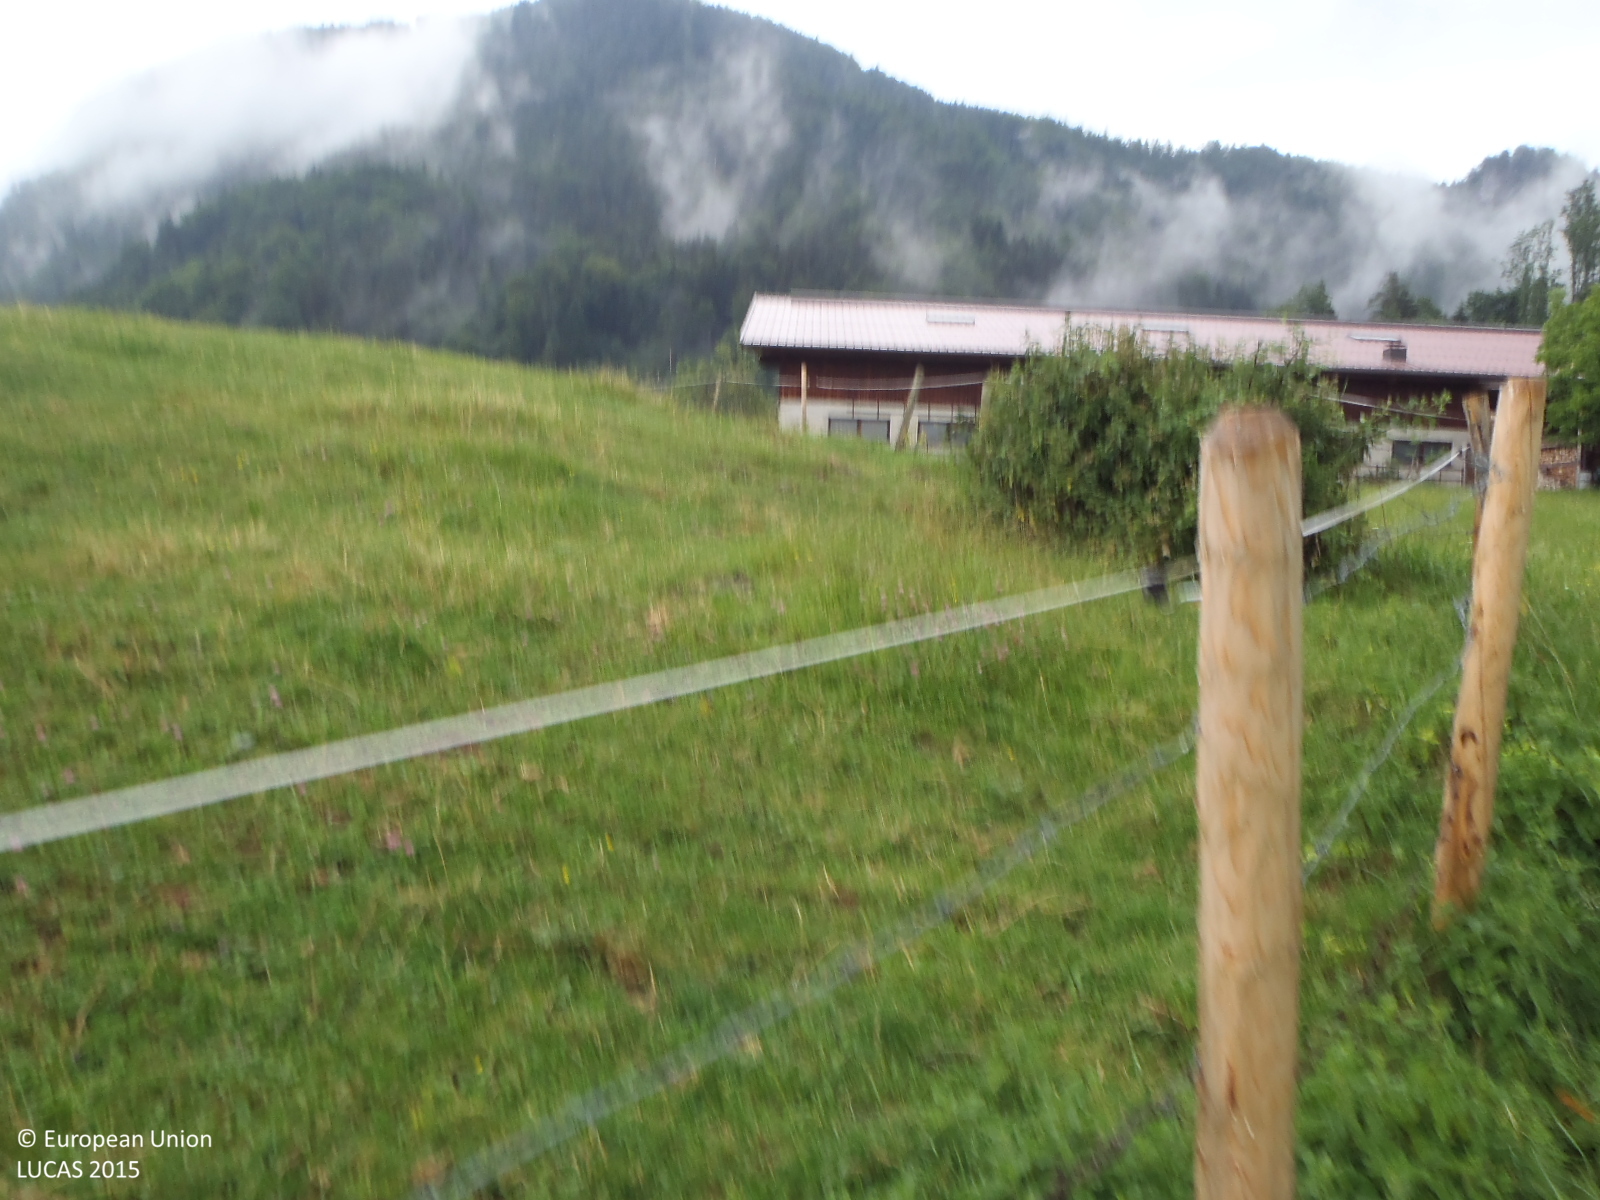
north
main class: Grassland
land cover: Grassland without tree/shrub cover
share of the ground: > 75 %
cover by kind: herbaceous plants 100 %
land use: Agriculture (excluding fallow land and kitchen gardens)
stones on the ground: < 10 %
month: July
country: AT
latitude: 47.6796
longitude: 12.1965
